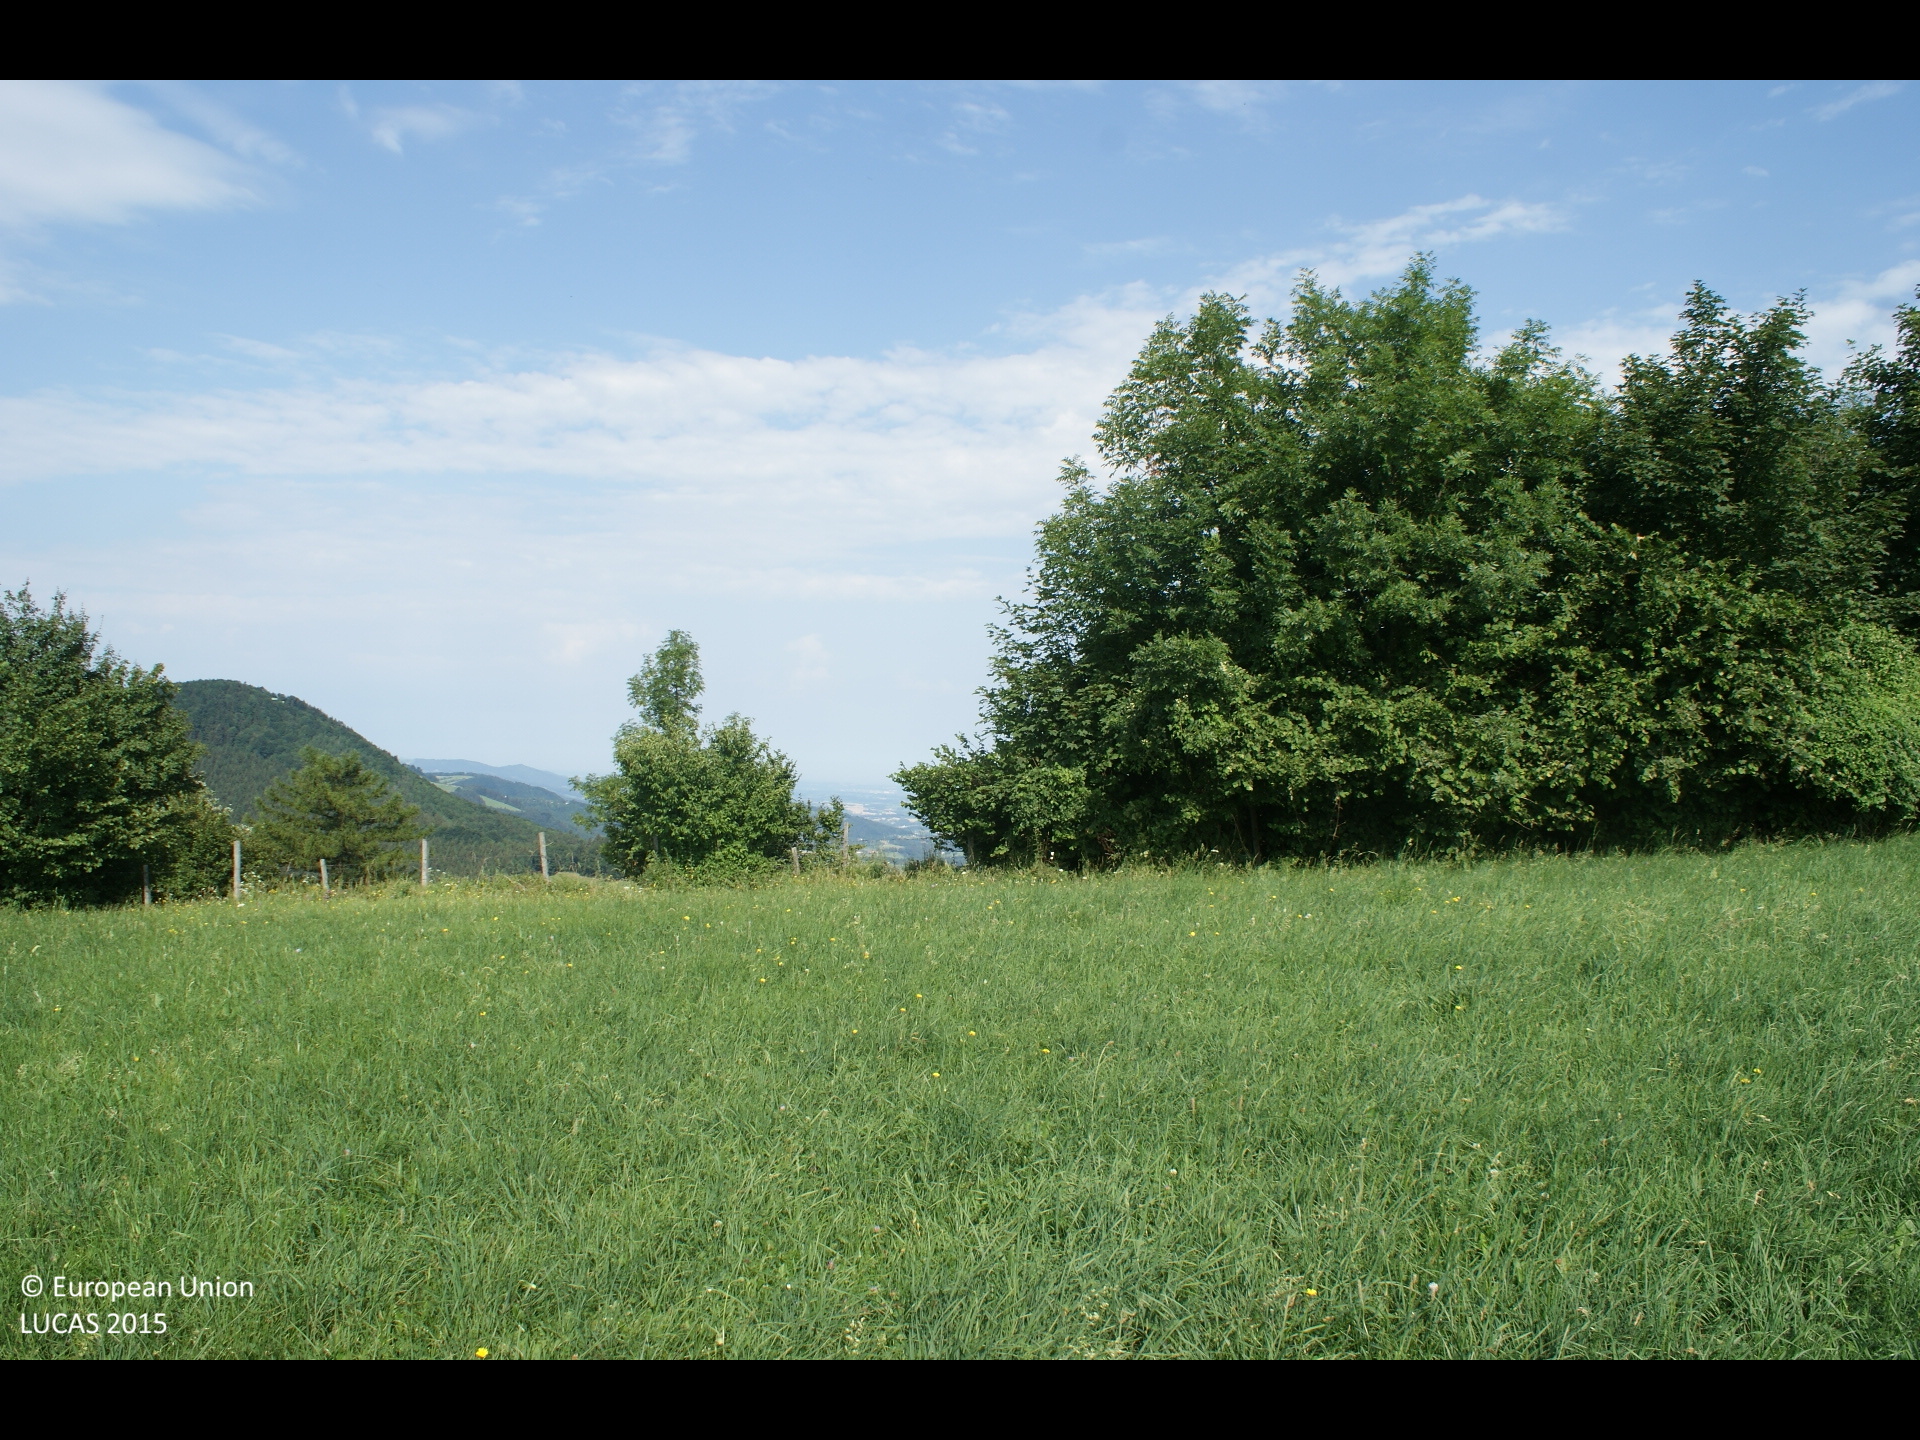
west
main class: Grassland
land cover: Grassland without tree/shrub cover
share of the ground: > 75 %
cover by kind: herbaceous plants 100 %
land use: Agriculture (excluding fallow land and kitchen gardens)
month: July
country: AT
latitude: 48.0215
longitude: 15.3515
